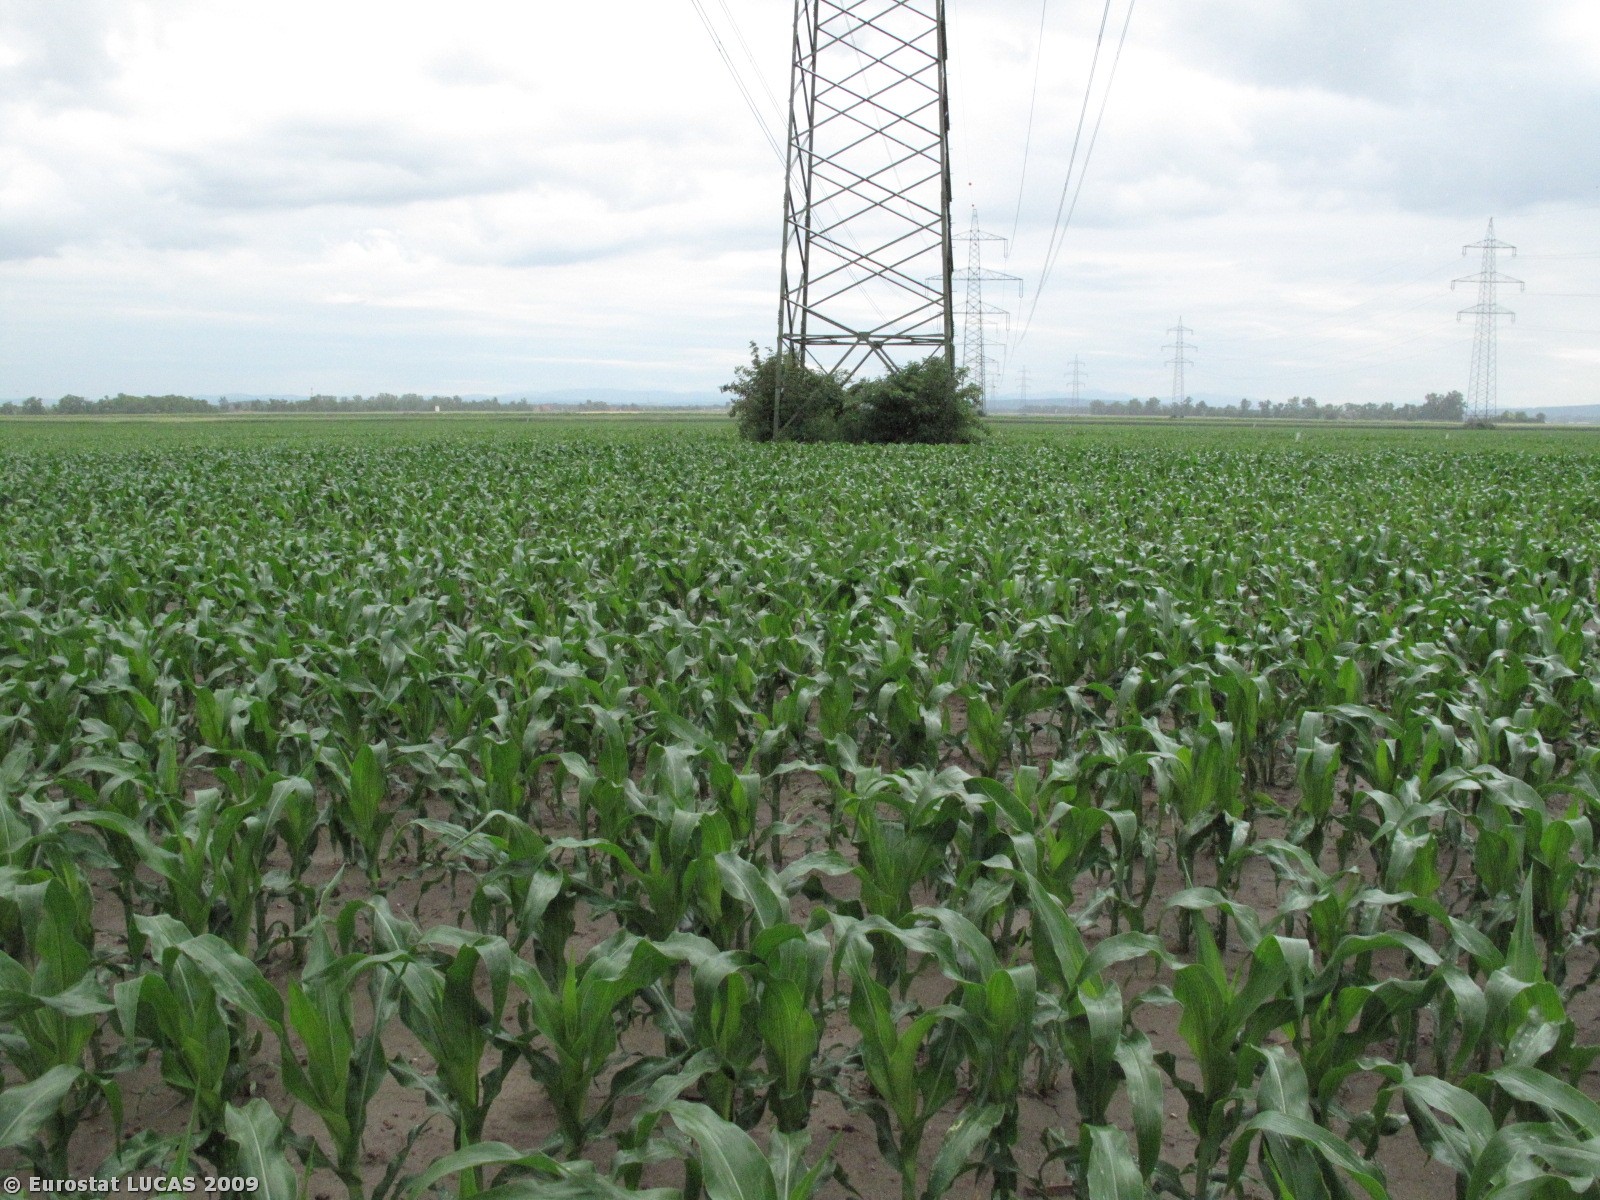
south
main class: Cropland
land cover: Maize
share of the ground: 25 - 50 %
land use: Agriculture (excluding fallow land and kitchen gardens)
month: June
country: AT
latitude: 48.4273
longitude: 15.8825
